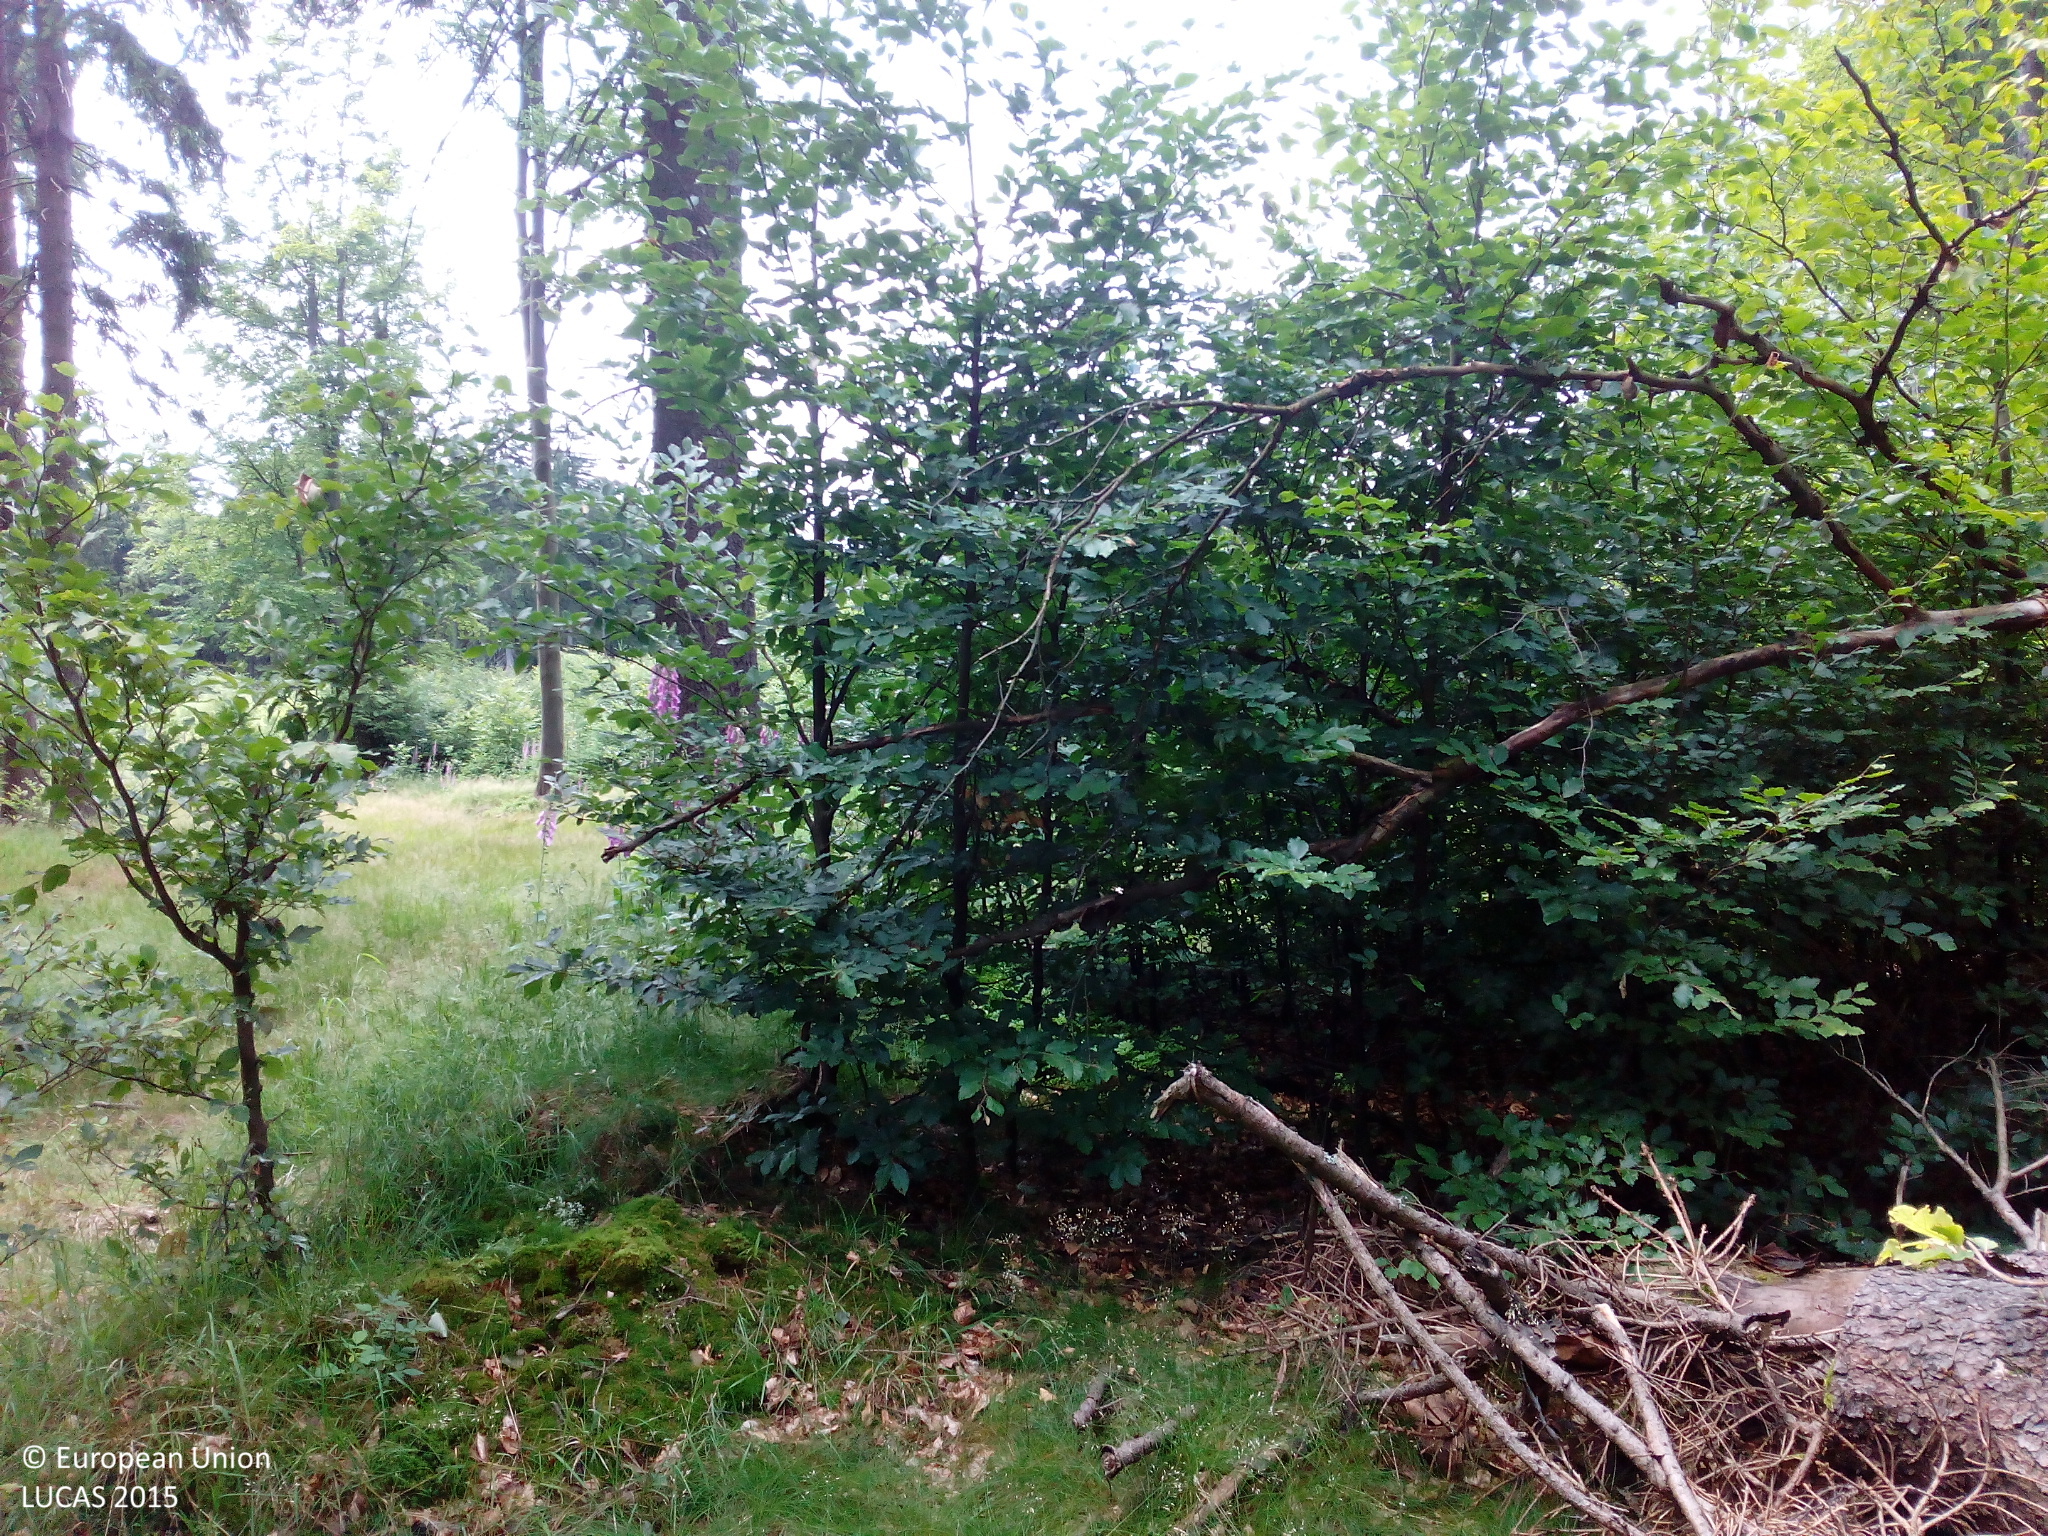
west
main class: Woodland
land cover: Spruce dominated mixed woodland
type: hemiboreal forest and nemoral coniferous forest and mixed broadleaved-coniferous forest
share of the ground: > 75 %
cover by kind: coniferous forest trees 60 %, broadleaved forest trees 25 %, shrubs 5 %, herbaceous plants 5 %, lichens and mosses 5 %
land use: Forestry
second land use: Amenities, museums, leisure
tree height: > 5 m
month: July
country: DE
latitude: 49.7452
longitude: 12.4004
